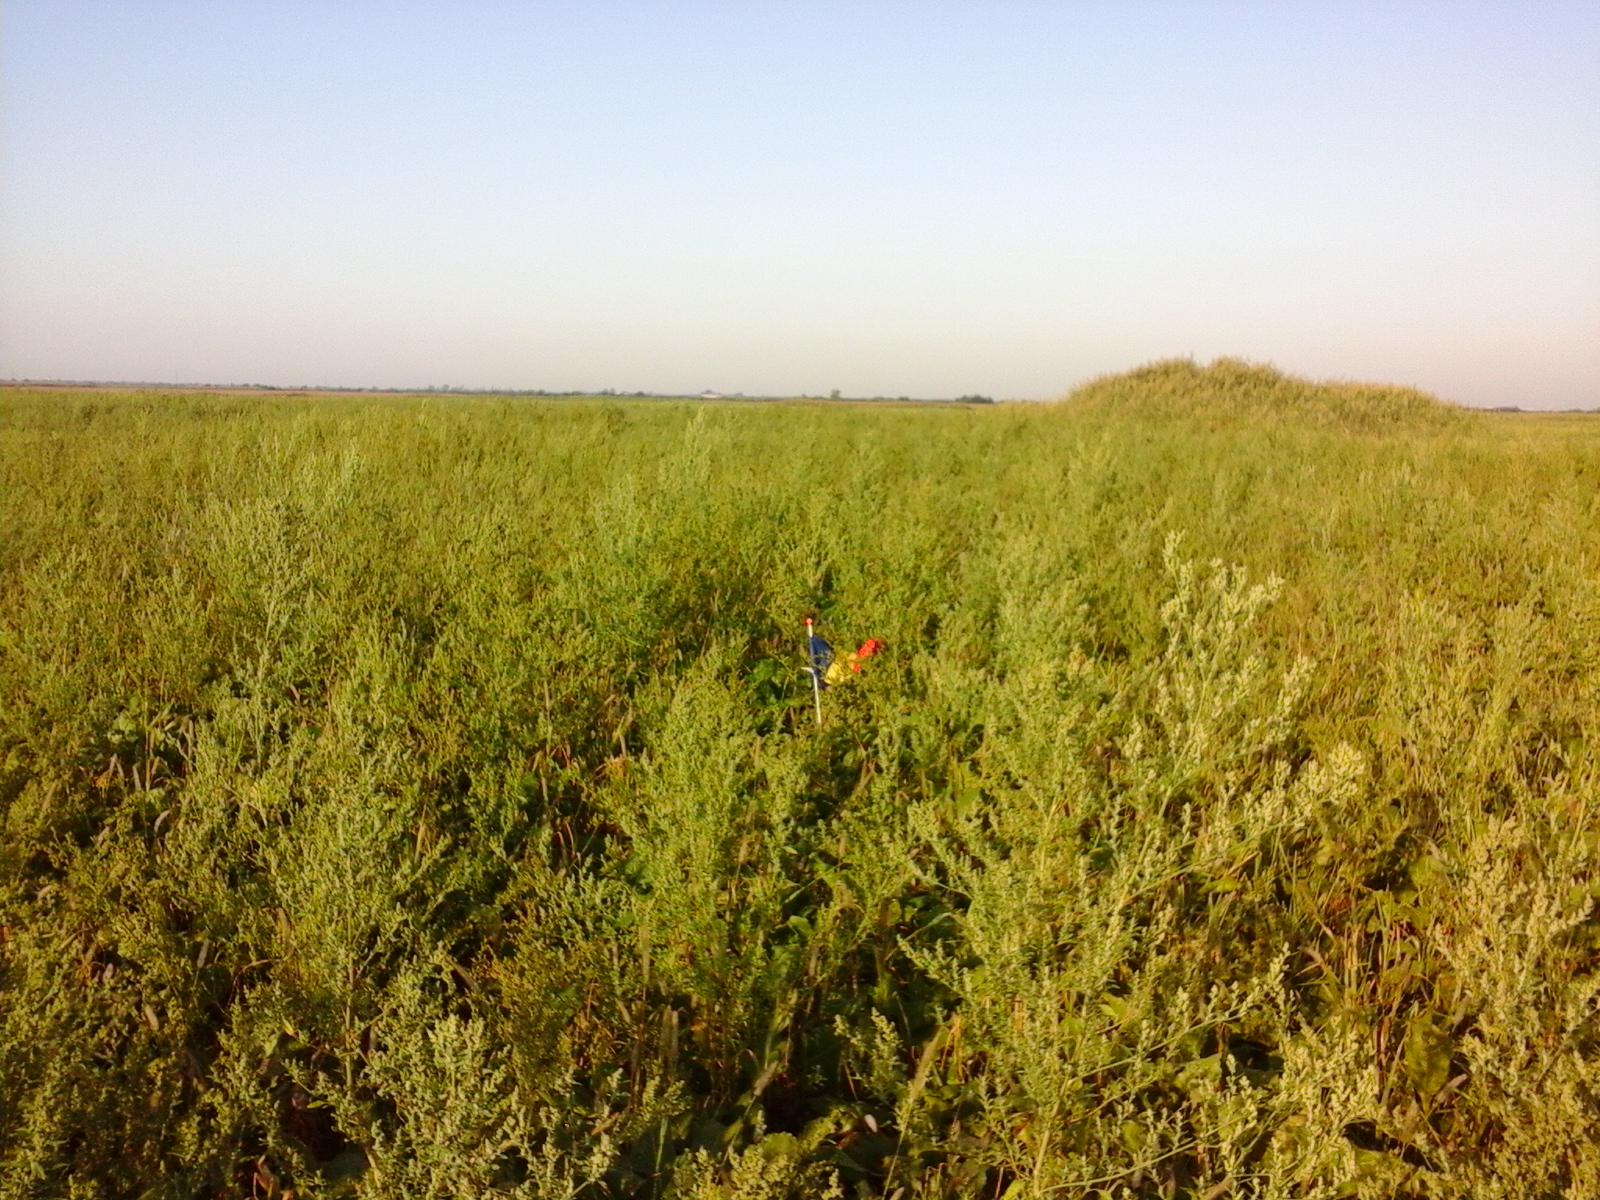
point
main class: Cropland
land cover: Sugar beet
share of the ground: 10 - 25 %
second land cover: Spontaneously vegetated surfaces
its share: > 75 %
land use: Agriculture (excluding fallow land and kitchen gardens)
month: August
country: RO
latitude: 45.7946
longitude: 21.0541
